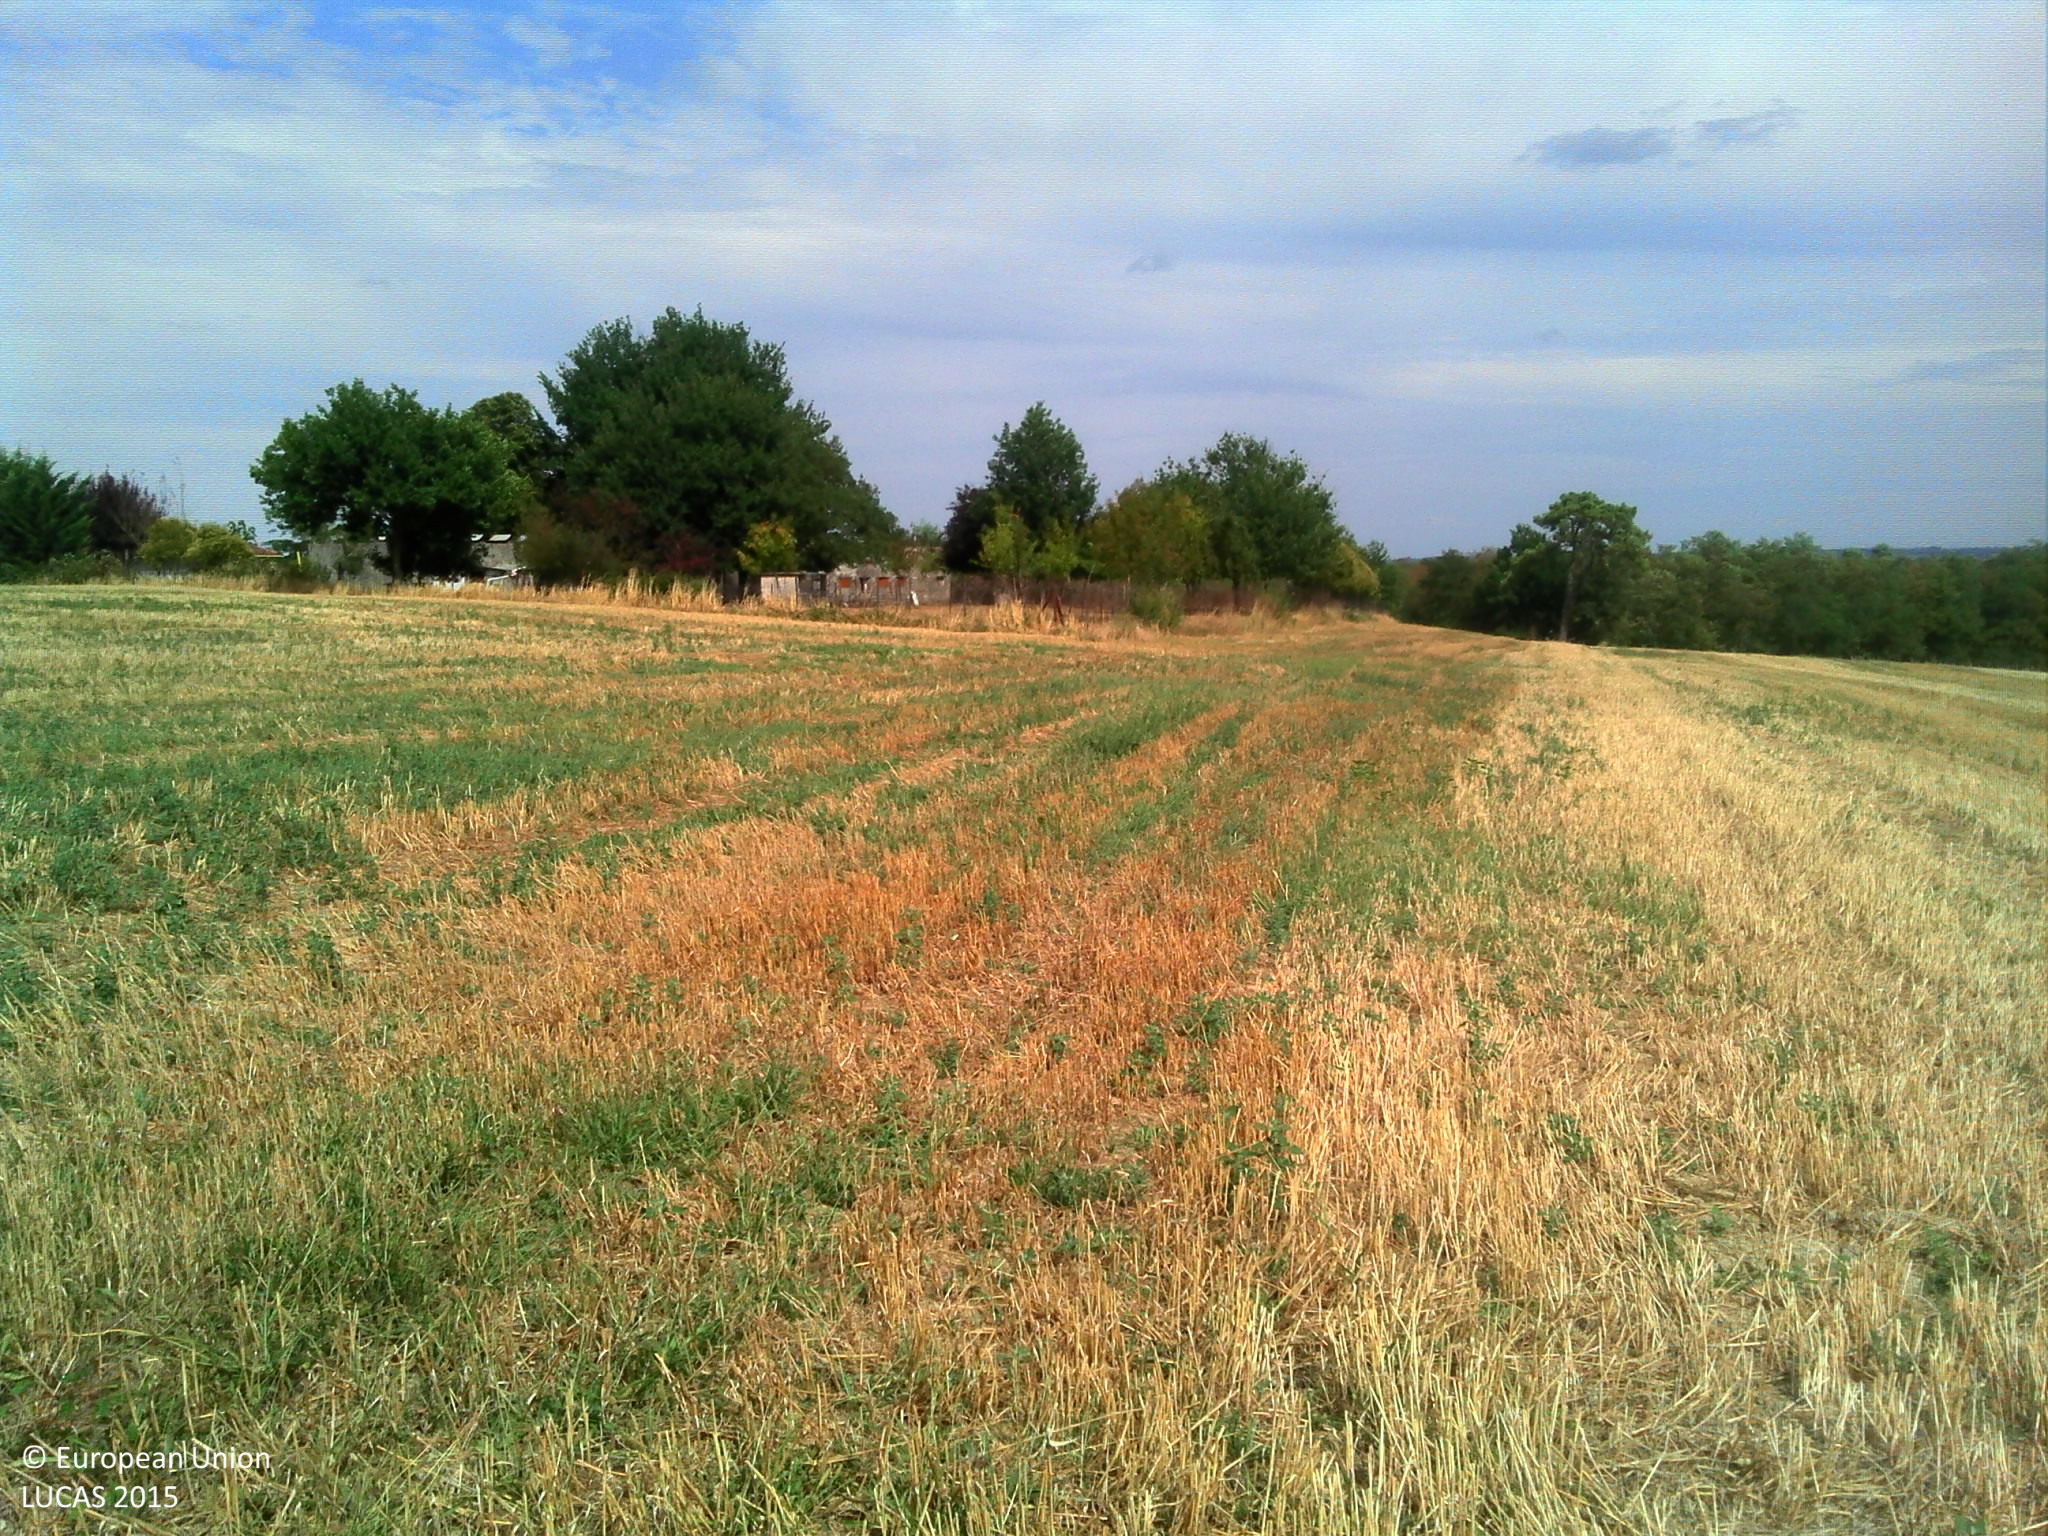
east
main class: Cropland
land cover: Common wheat
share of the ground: > 75 %
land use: Agriculture (excluding fallow land and kitchen gardens)
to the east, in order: Common wheat; Fences; Grassland with sparse tree/shrub cover; Fences; Grassland with sparse tree/shrub cover; Fences; Grassland with sparse tree/shrub cover; Fences; Grassland with sparse tree/shrub cover; Fences; Grassland with sparse tree/shrub cover; Fences; Temporary grasslands; Broadleaved woodland
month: July
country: FR
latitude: 44.1124
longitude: 0.6872
